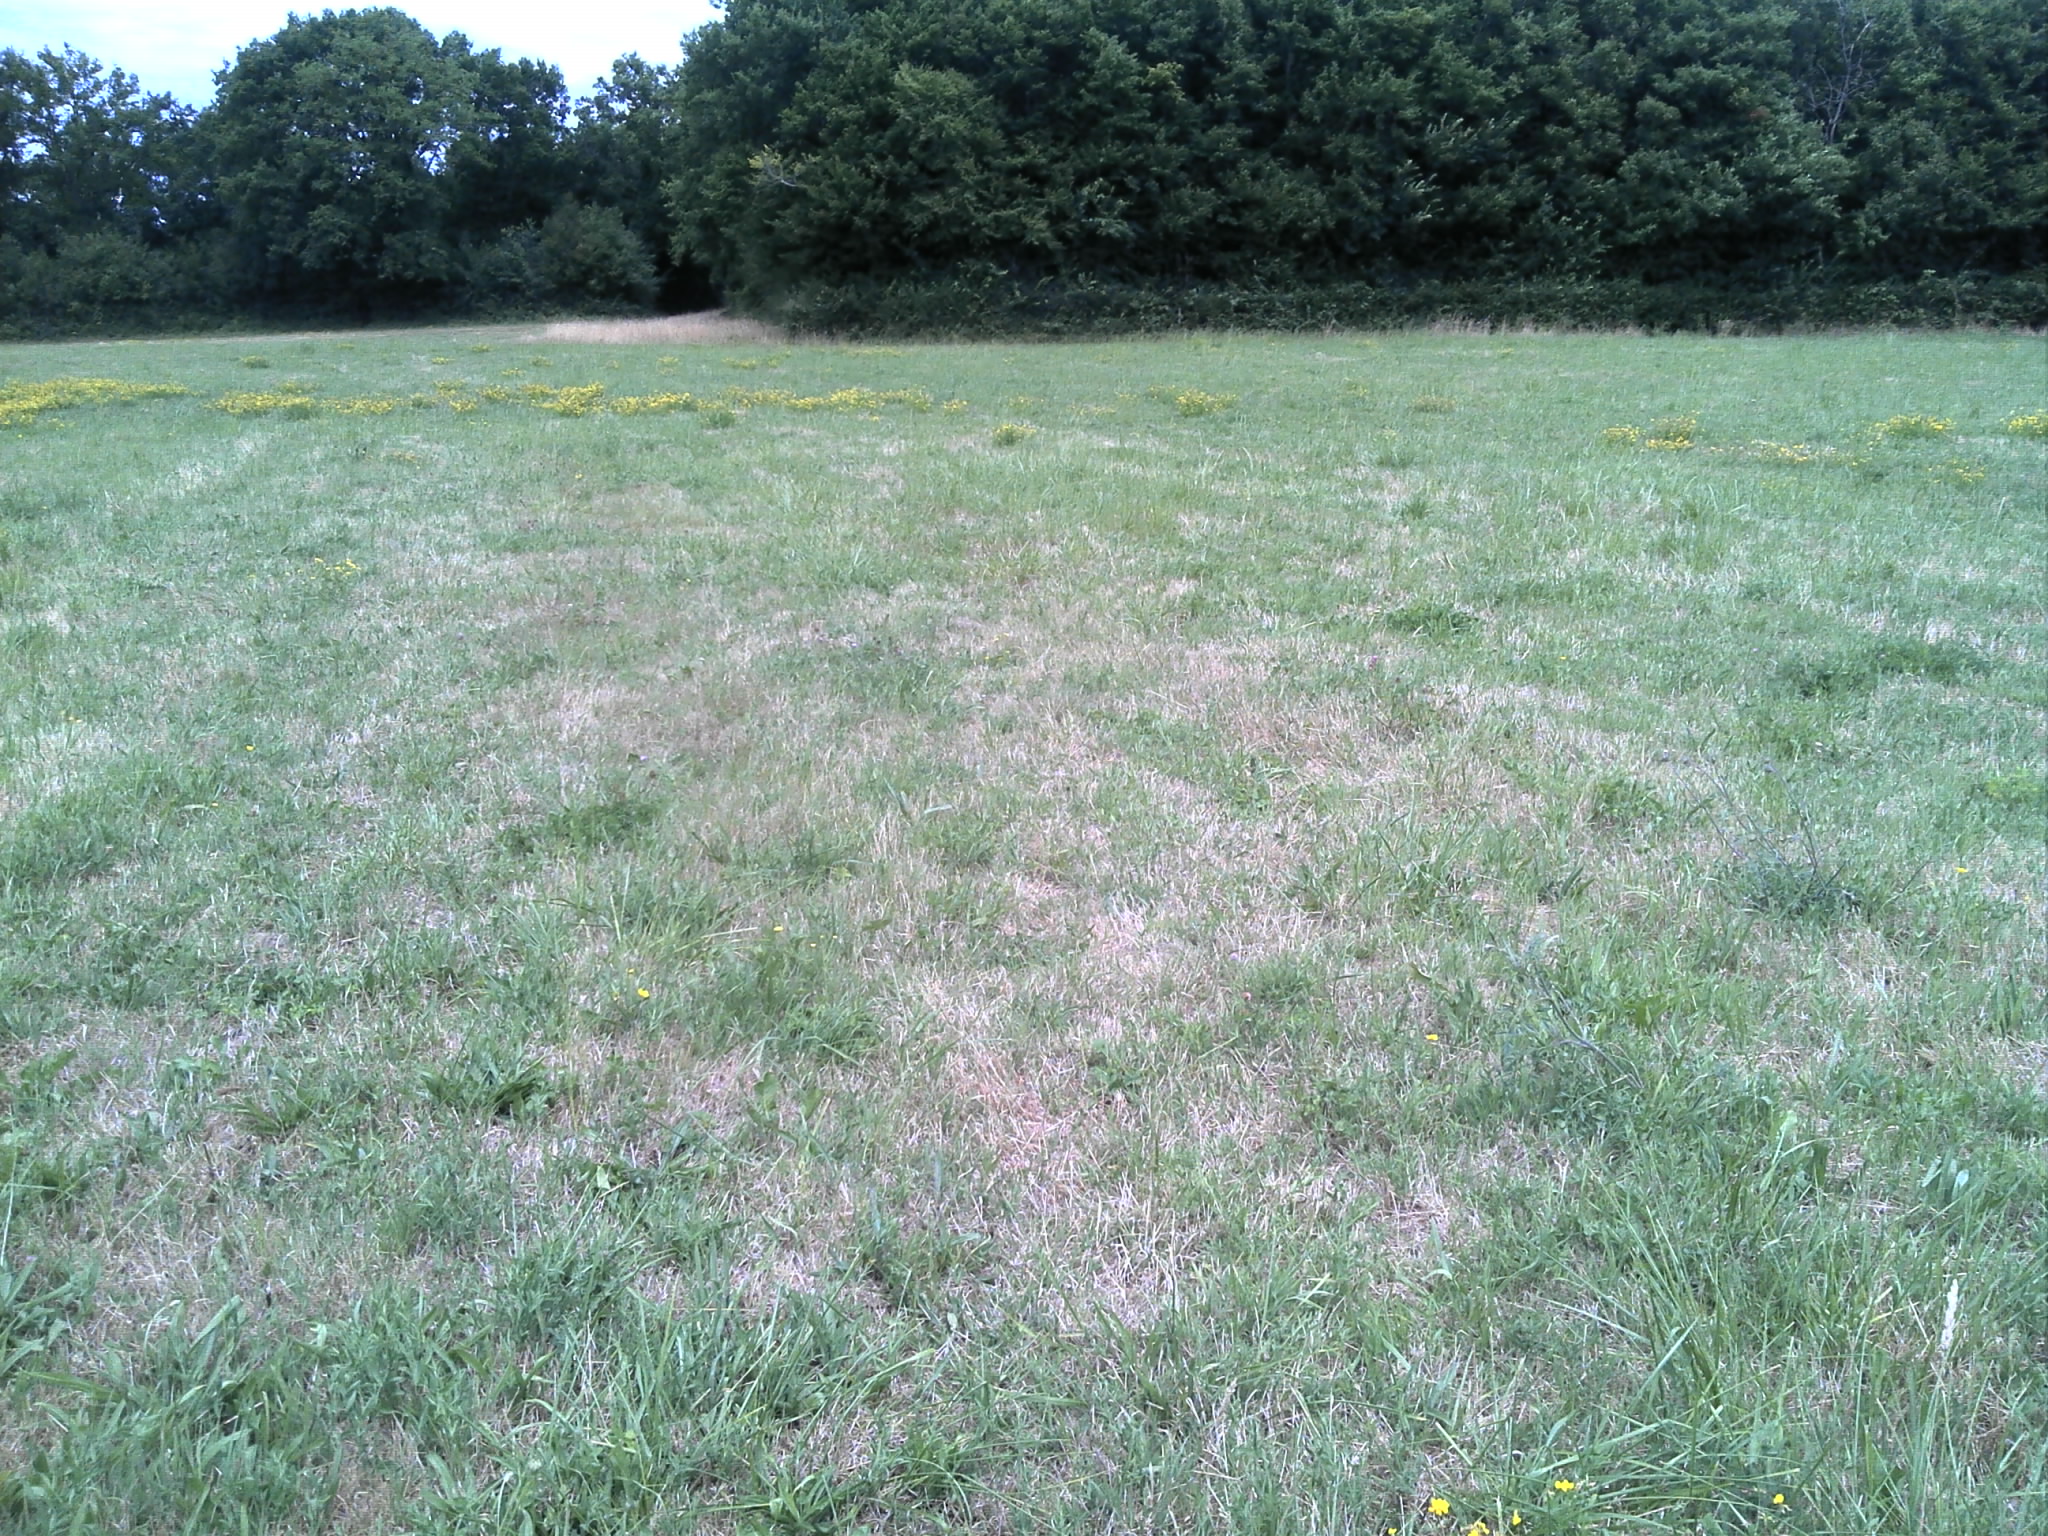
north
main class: Grassland
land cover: Grassland without tree/shrub cover
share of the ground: > 75 %
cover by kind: herbaceous plants 100 %
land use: Agriculture (excluding fallow land and kitchen gardens)
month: July
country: FR
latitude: 46.7184
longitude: 1.4982
